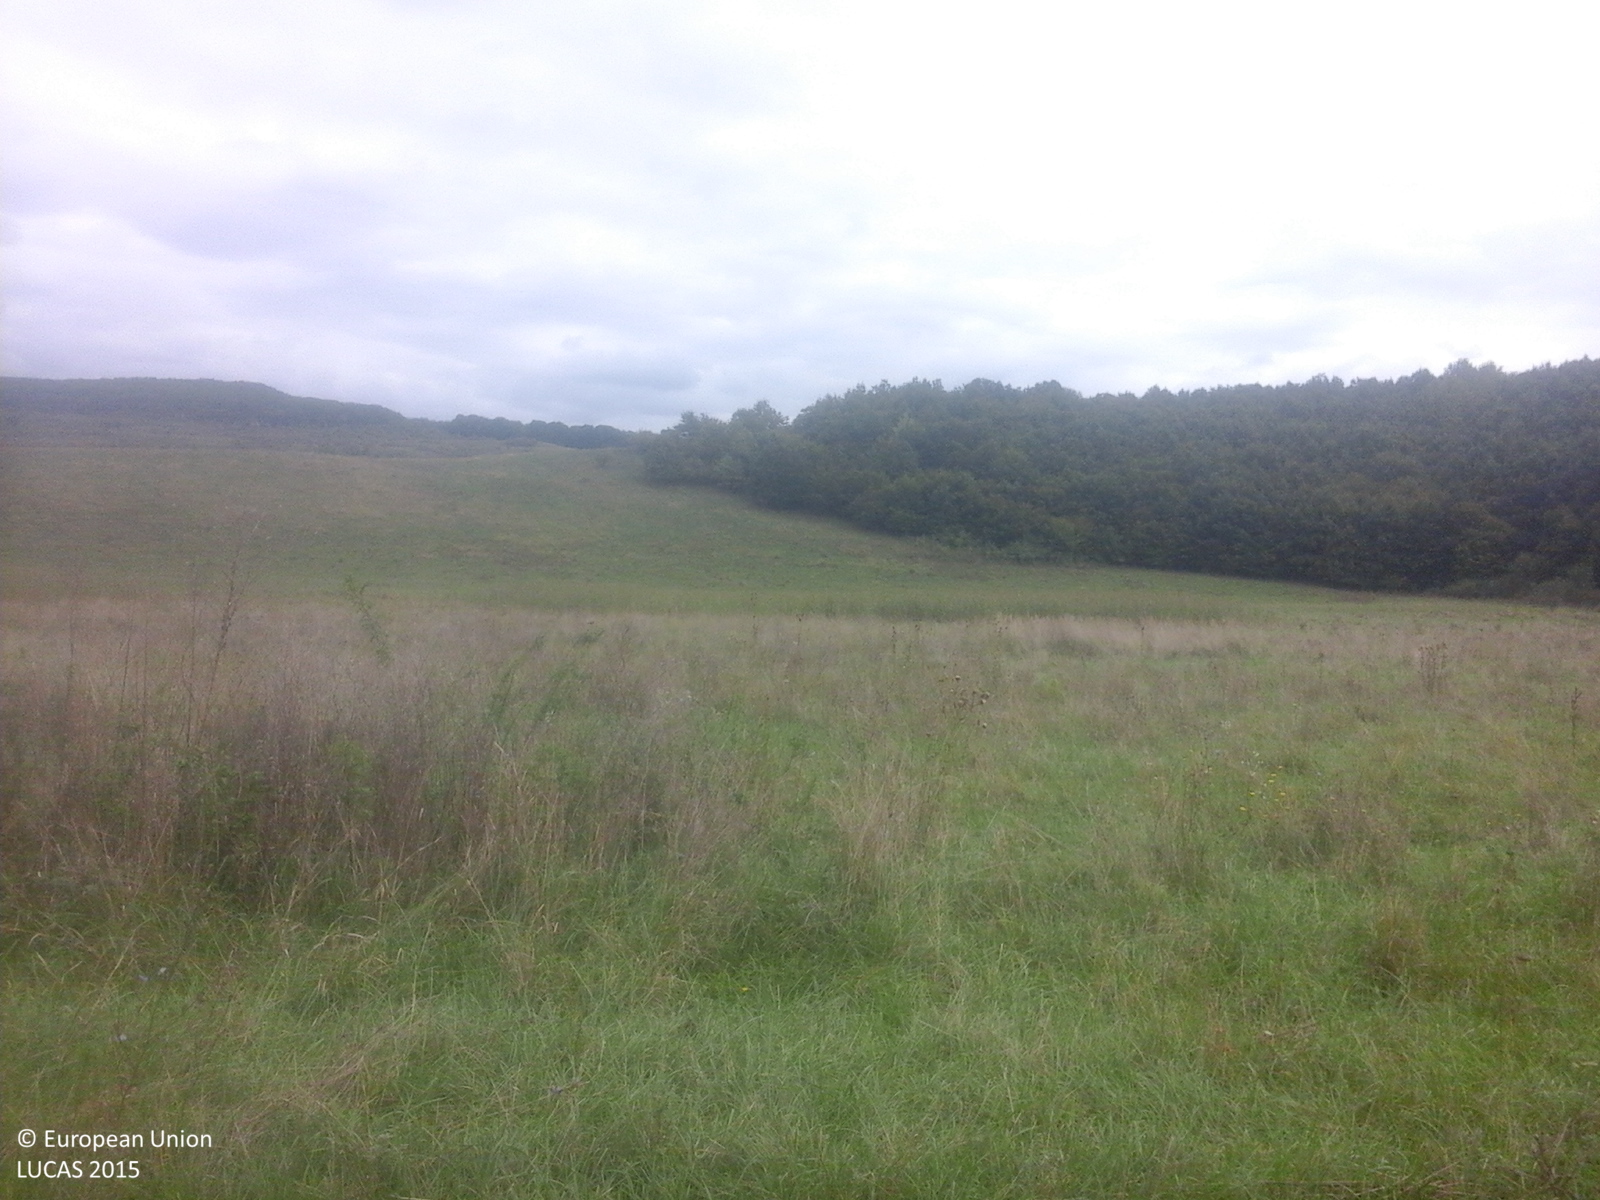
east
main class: Cropland
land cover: Maize
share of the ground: > 75 %
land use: Agriculture (excluding fallow land and kitchen gardens)
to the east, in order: Maize; Fences; Grass margins; Tracks; Grassland without tree/shrub cover; Tracks; Grassland without tree/shrub cover
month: September
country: RO
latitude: 45.8597
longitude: 23.8906
